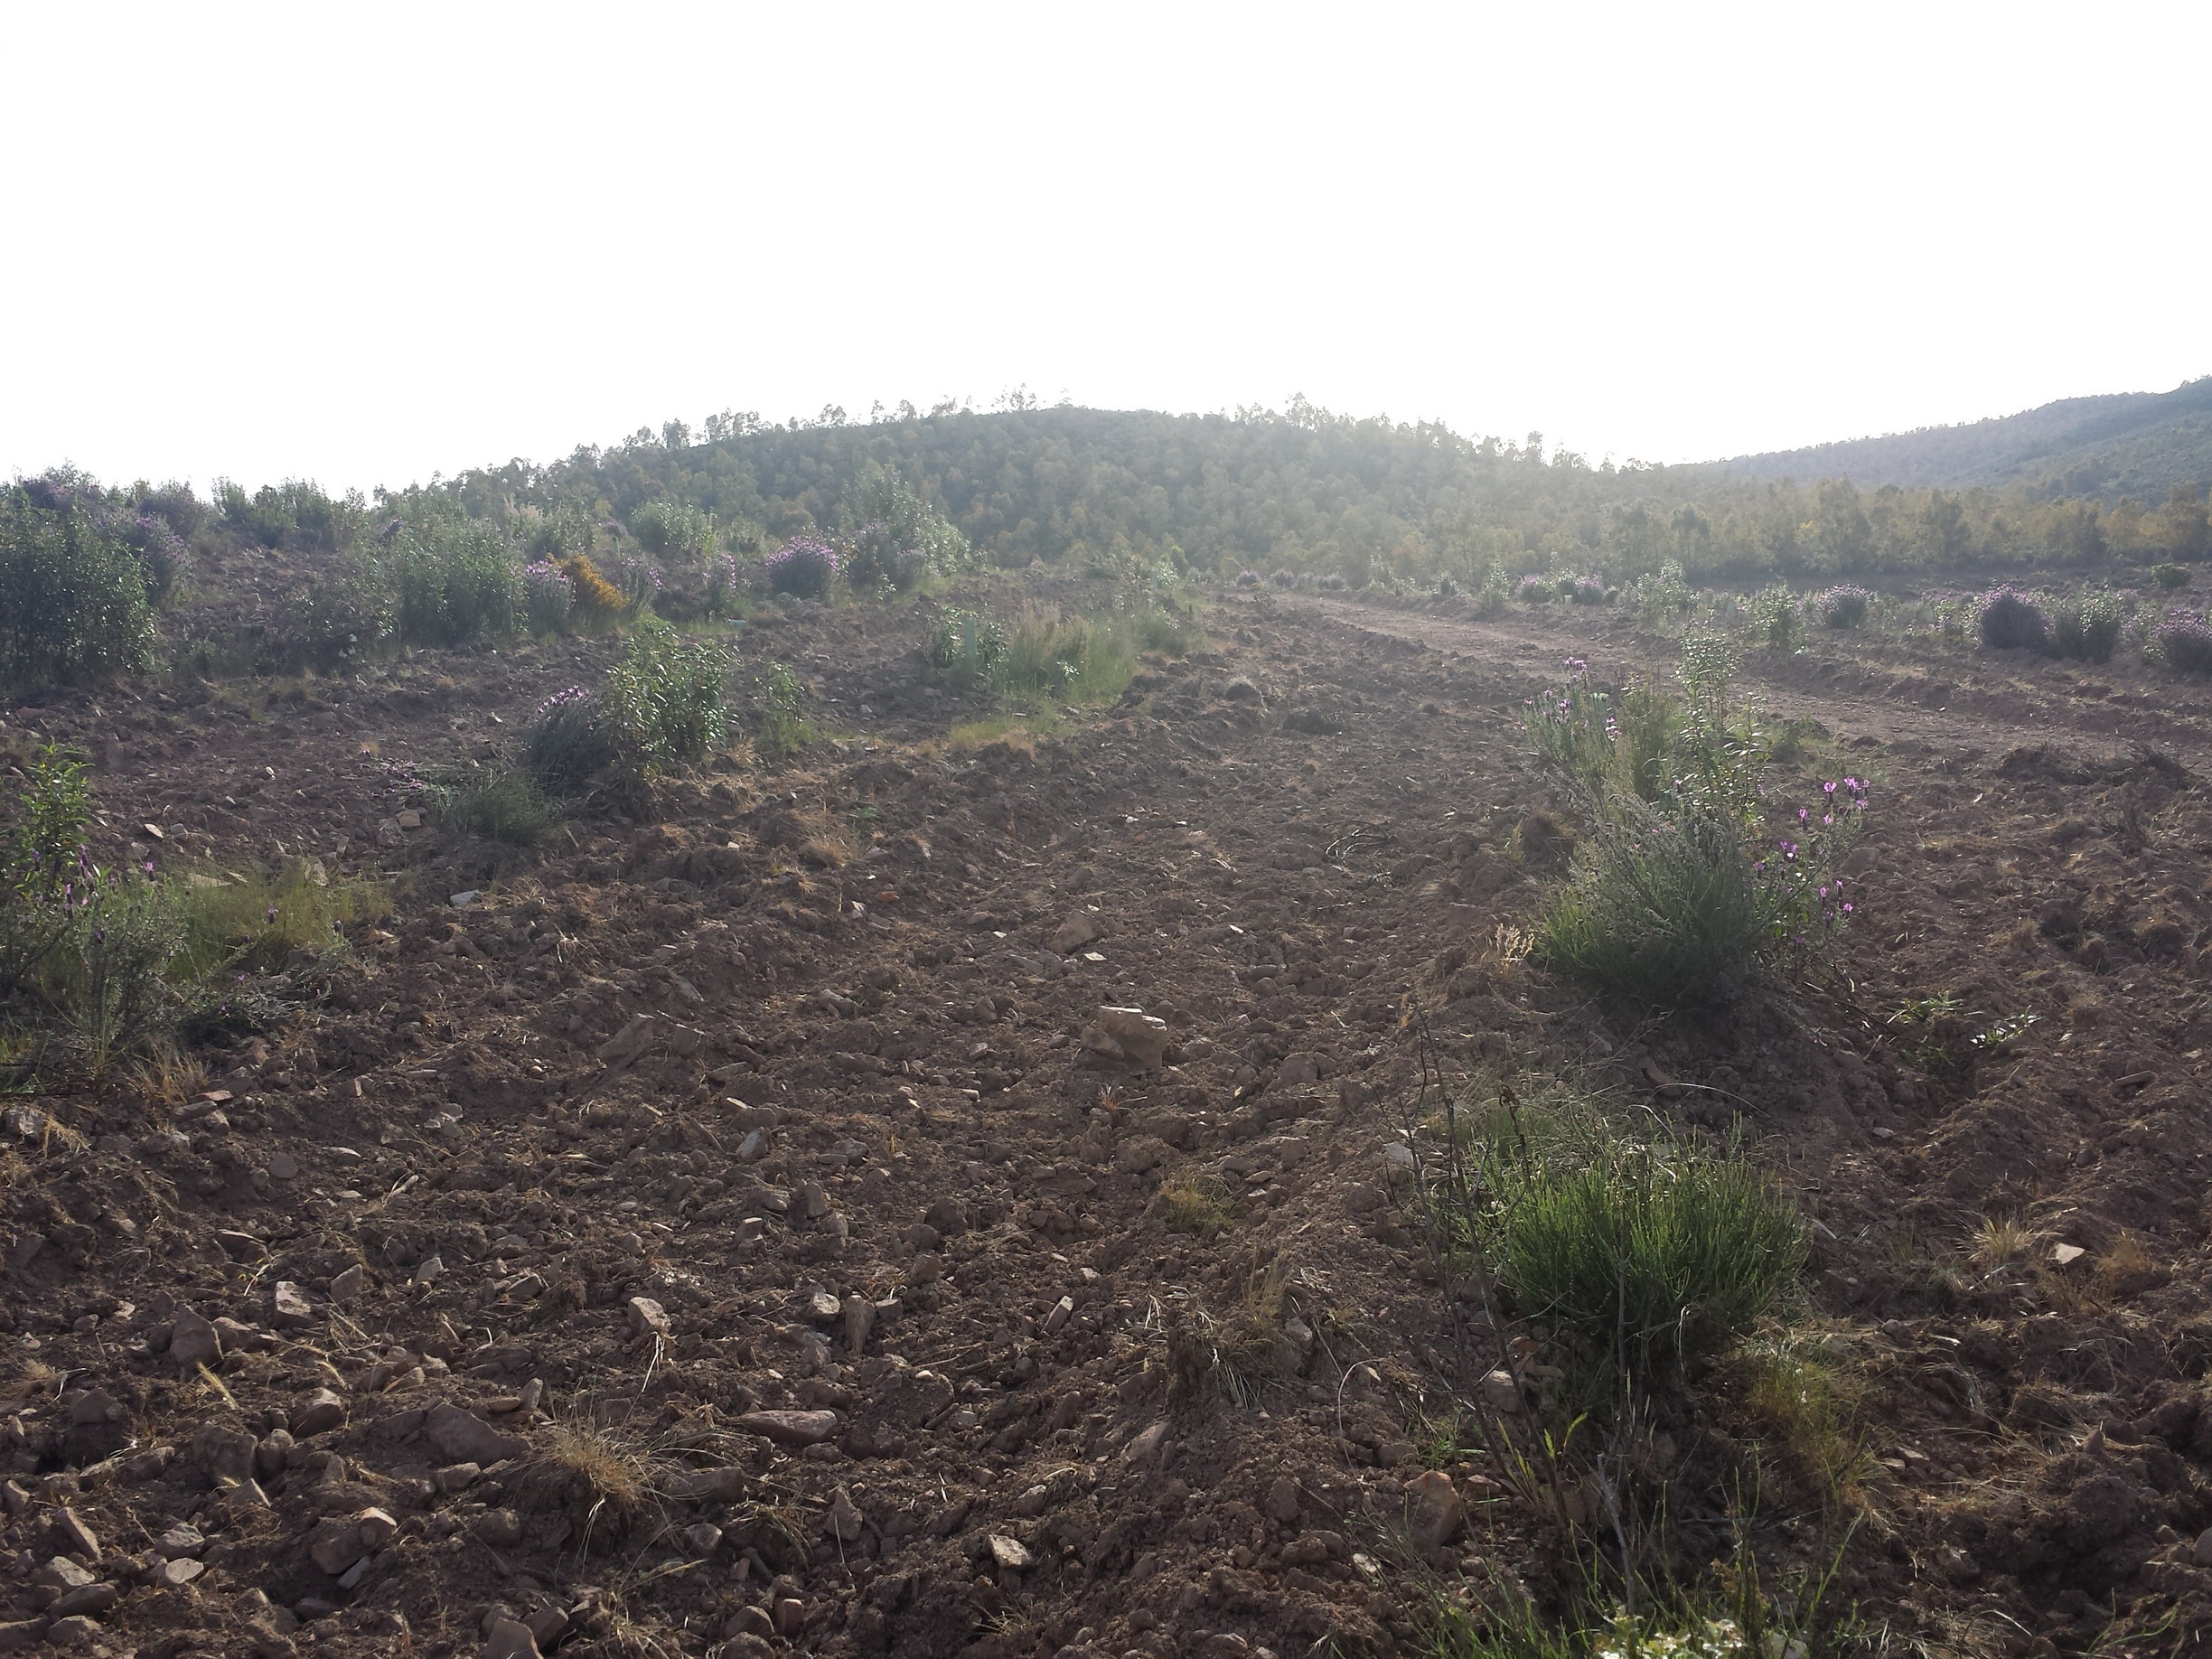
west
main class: Shrubland
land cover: Shrubland without tree cover
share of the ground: 10 - 25 %
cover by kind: unconsolidated bare surface 70 %, shrubs 15 %, herbaceous plants 15 %
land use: Forestry
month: May
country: ES
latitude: 39.5856
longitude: -7.1915
